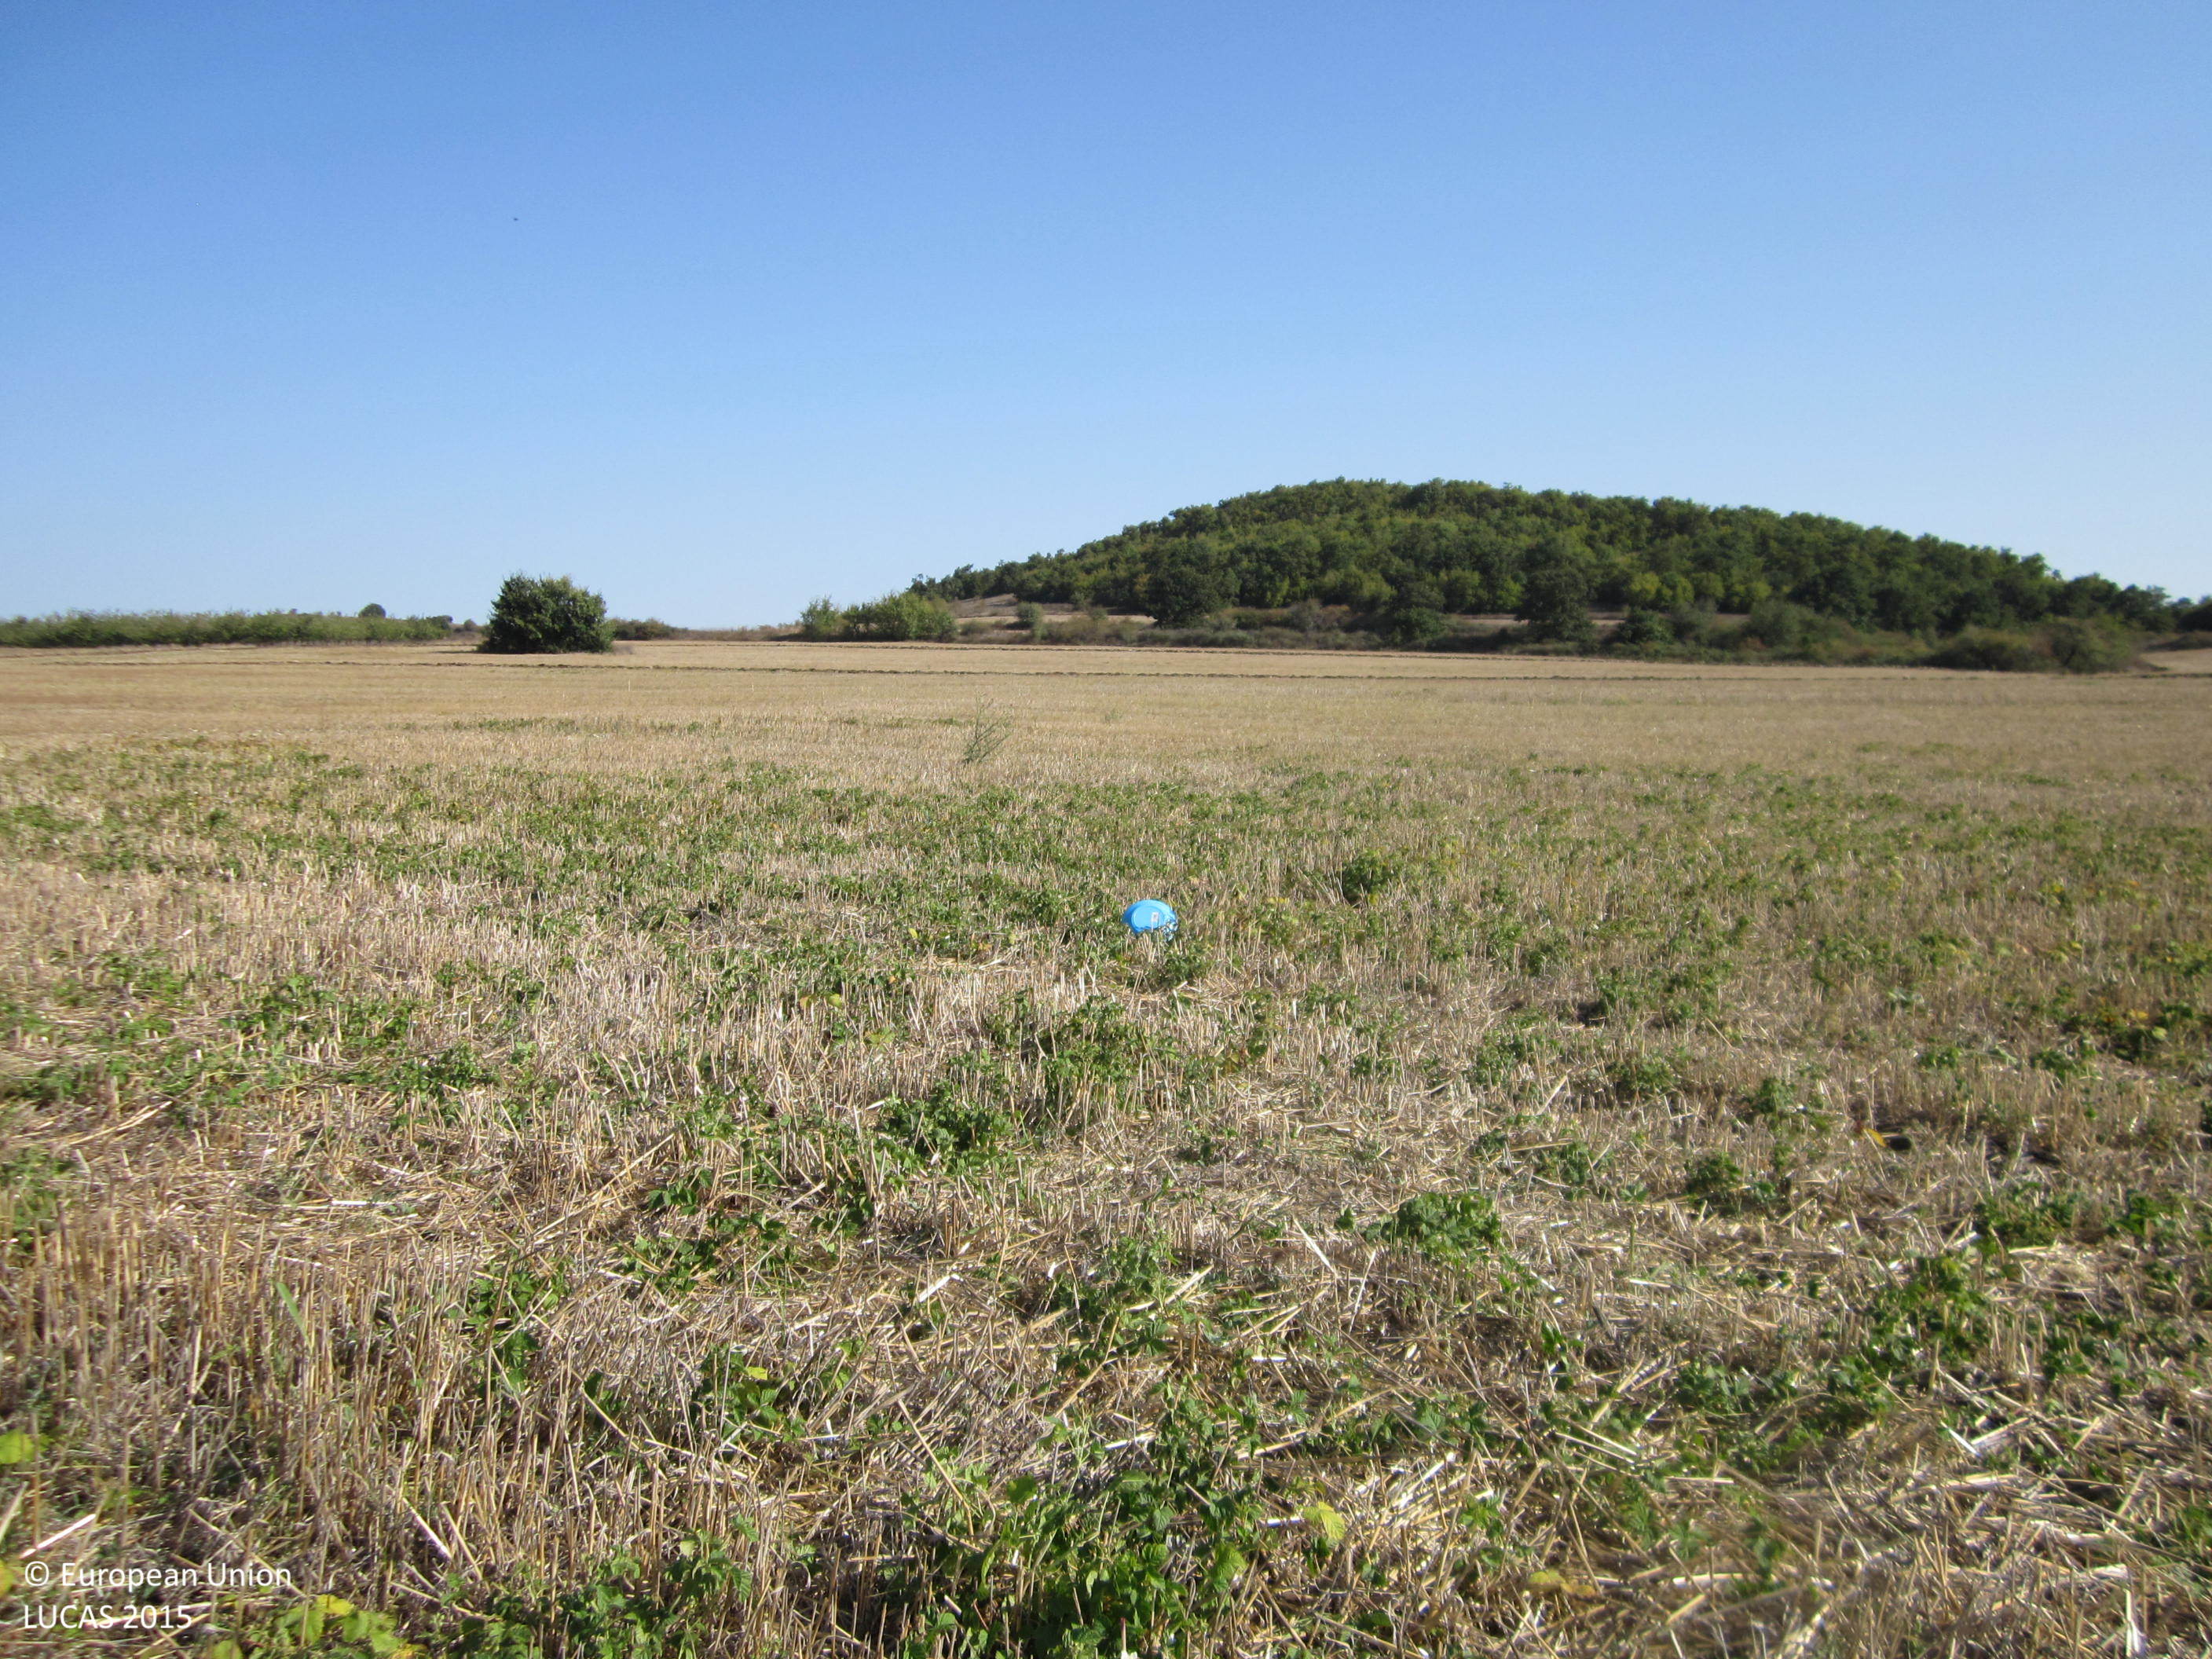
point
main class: Cropland
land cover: Common wheat
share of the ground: 25 - 50 %
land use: Agriculture (excluding fallow land and kitchen gardens)
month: September
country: BG
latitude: 42.7063
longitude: 27.3680
